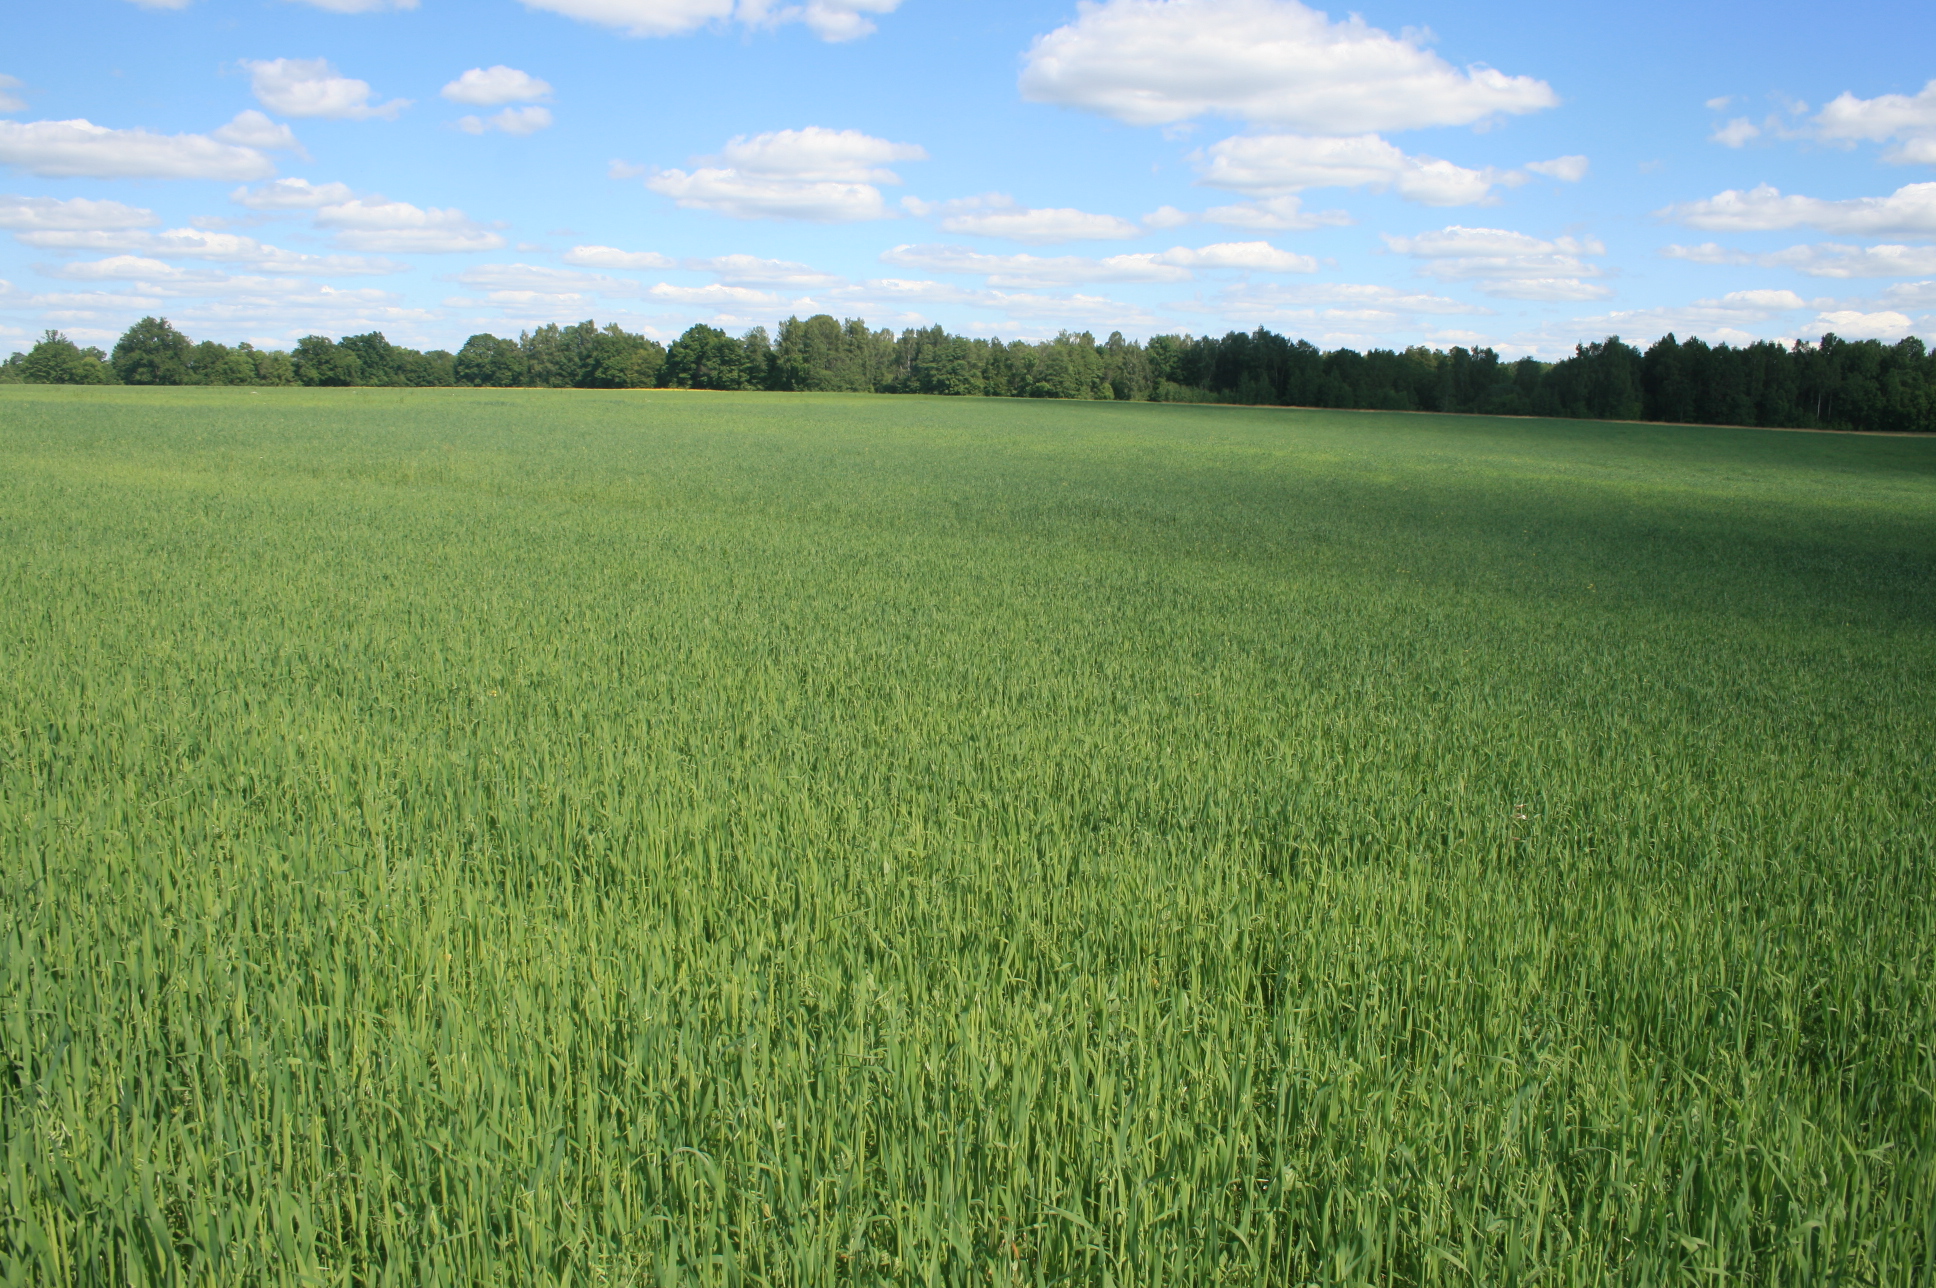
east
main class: Cropland
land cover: Other leguminous and mixtures for fodder
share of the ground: > 75 %
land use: Agriculture (excluding fallow land and kitchen gardens)
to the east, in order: Other leguminous and mixtures for fodder
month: June
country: LT
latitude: 55.3941
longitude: 22.1014
